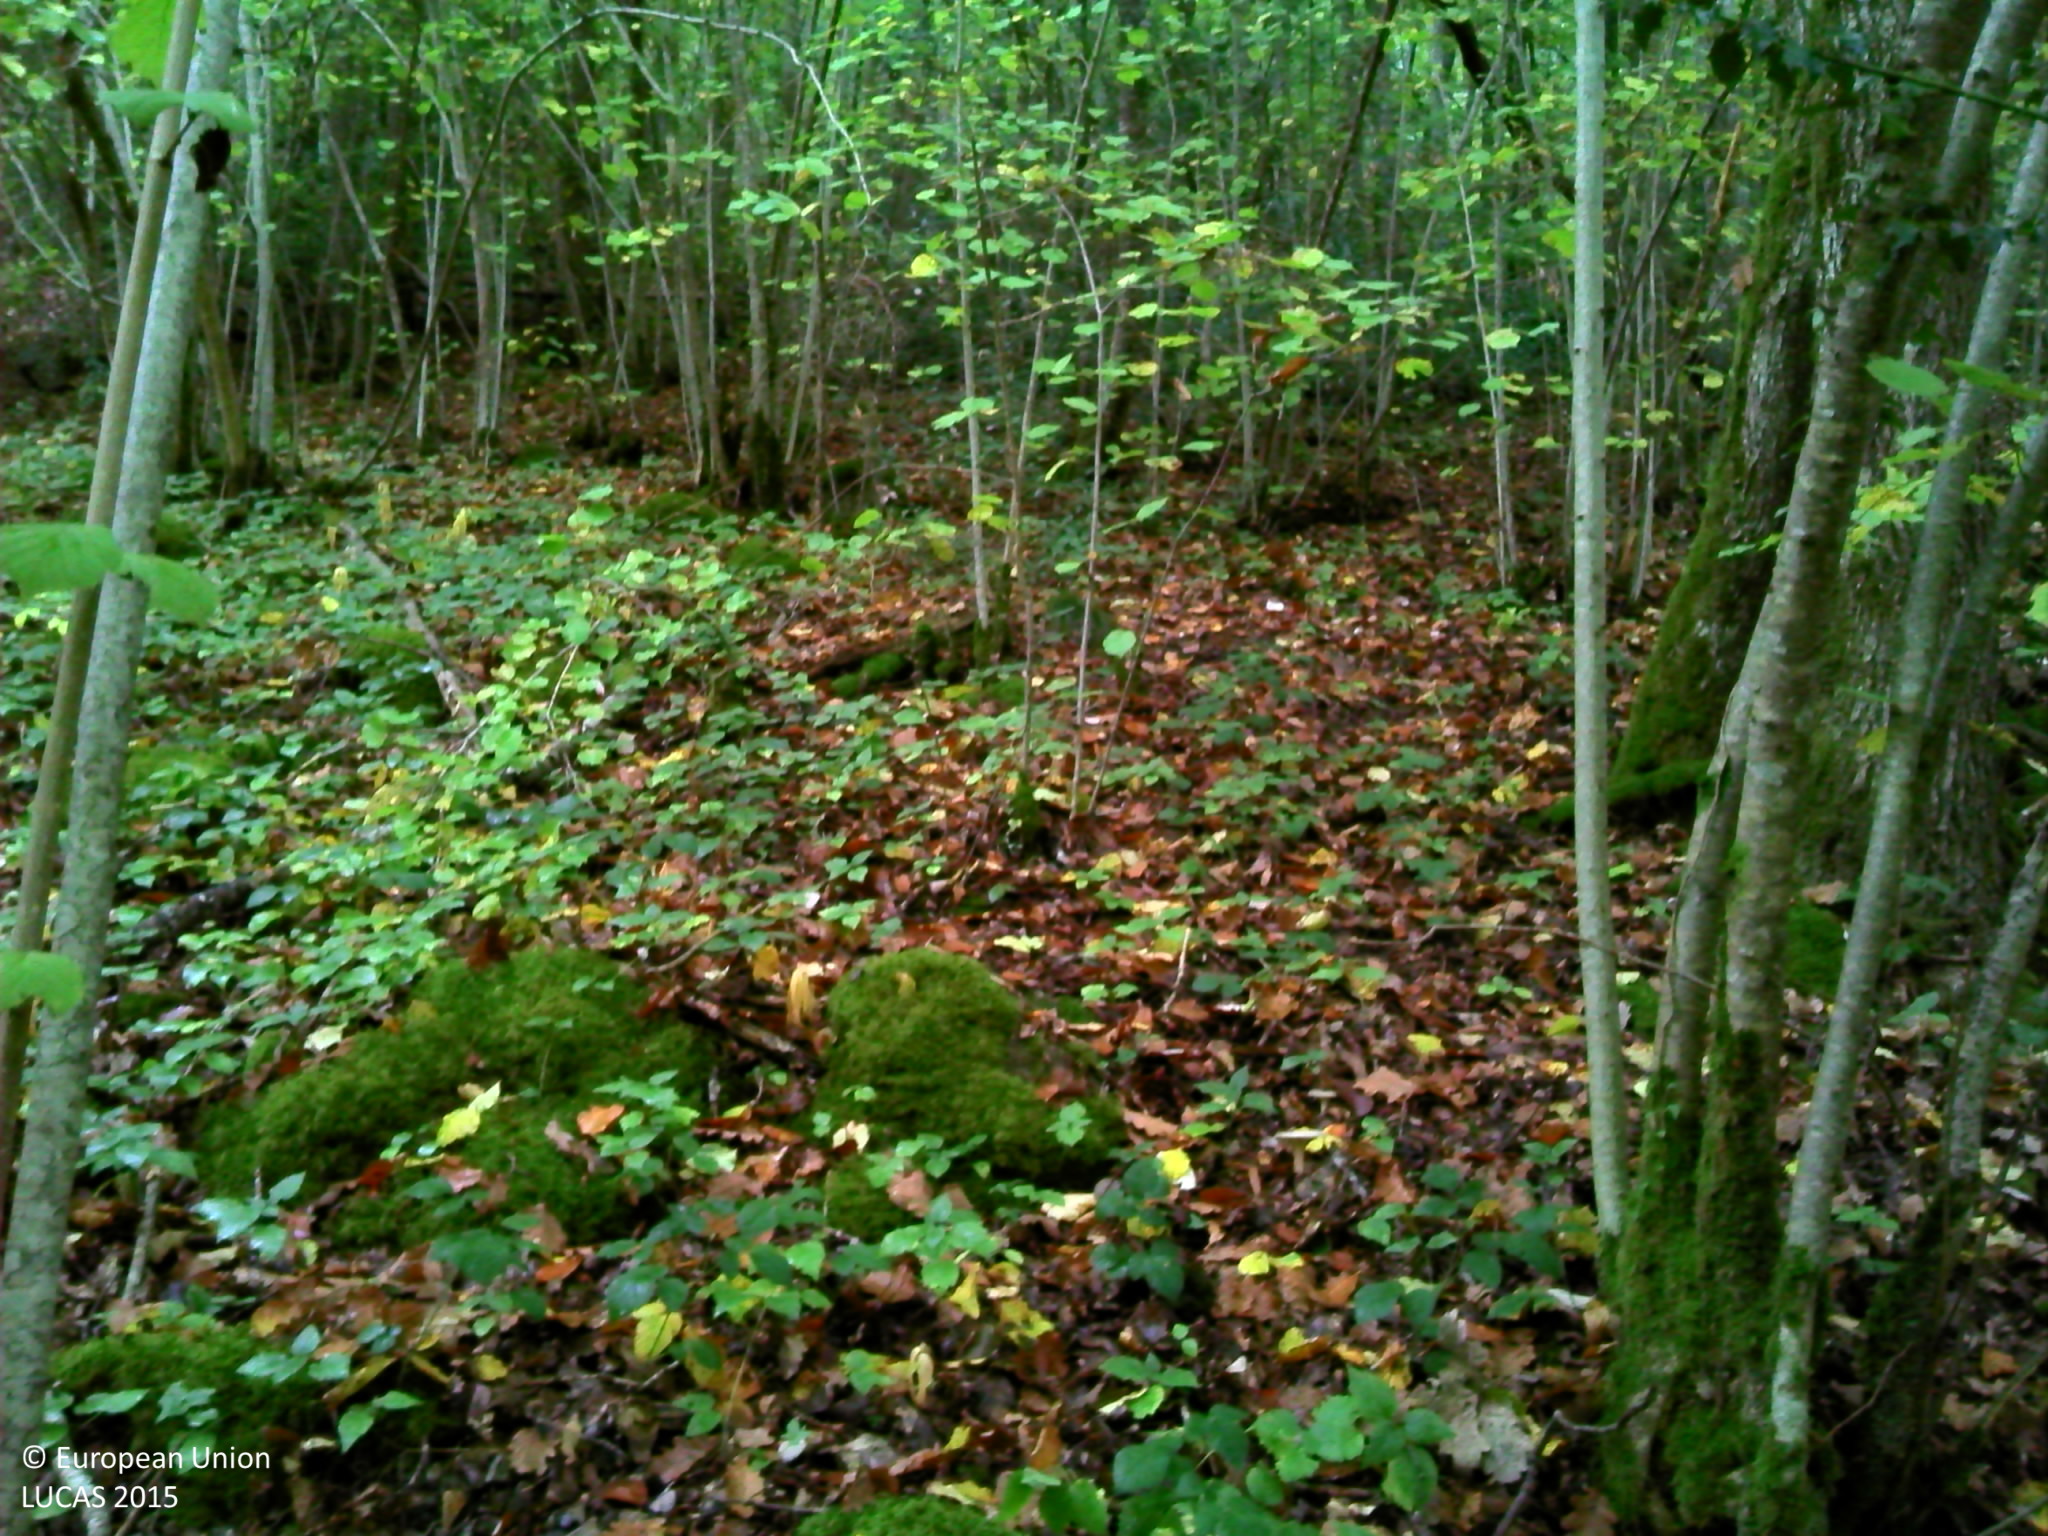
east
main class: Woodland
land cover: Broadleaved woodland
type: mesophytic deciduous forest
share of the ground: > 75 %
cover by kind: broadleaved forest trees 85 %, herbaceous plants 15 %
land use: Forestry
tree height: > 5 m
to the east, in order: Broadleaved woodland; Tracks; Broadleaved woodland; Tracks; Broadleaved woodland
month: October
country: FR
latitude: 45.9466
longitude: 2.8129
